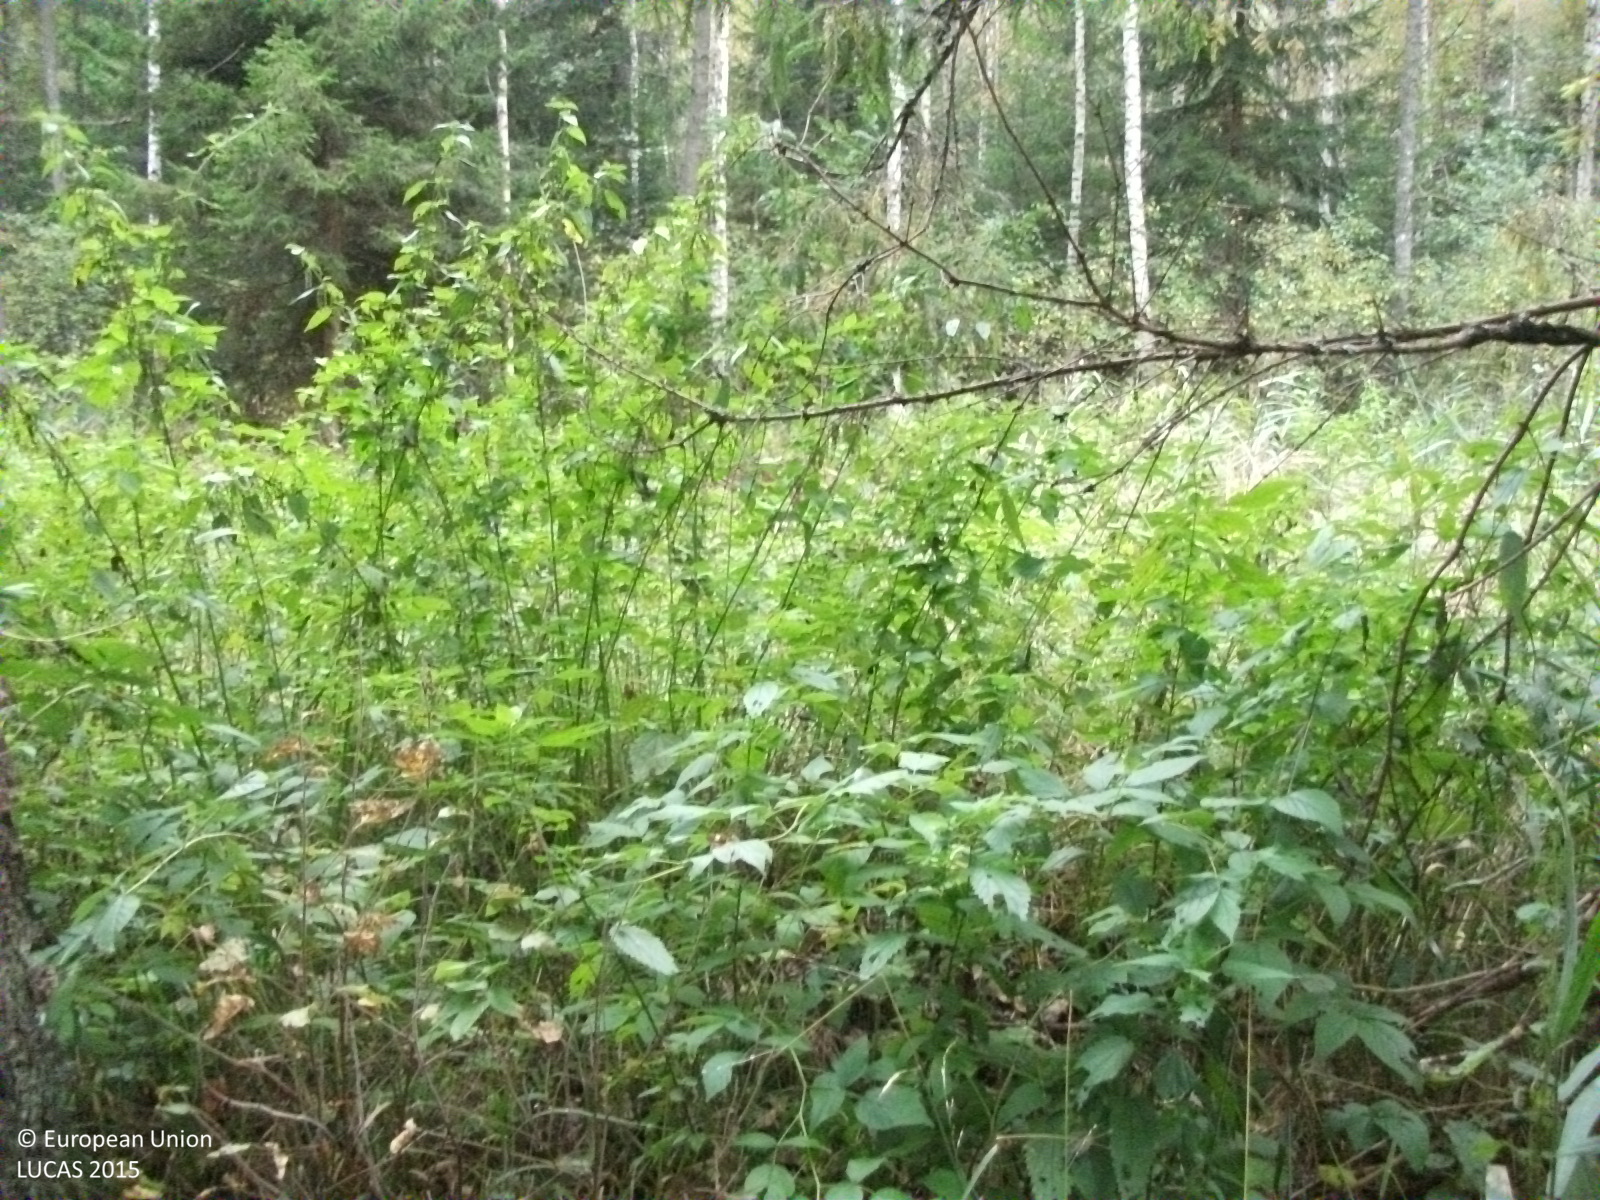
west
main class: Woodland
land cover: Broadleaved woodland
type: non-riverine alder, birch or aspen forest
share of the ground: > 75 %
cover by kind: broadleaved forest trees 90 %, shrubs 5 %, herbaceous plants 5 %
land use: Forestry
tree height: > 5 m
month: September
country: LV
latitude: 57.7505
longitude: 24.5579
